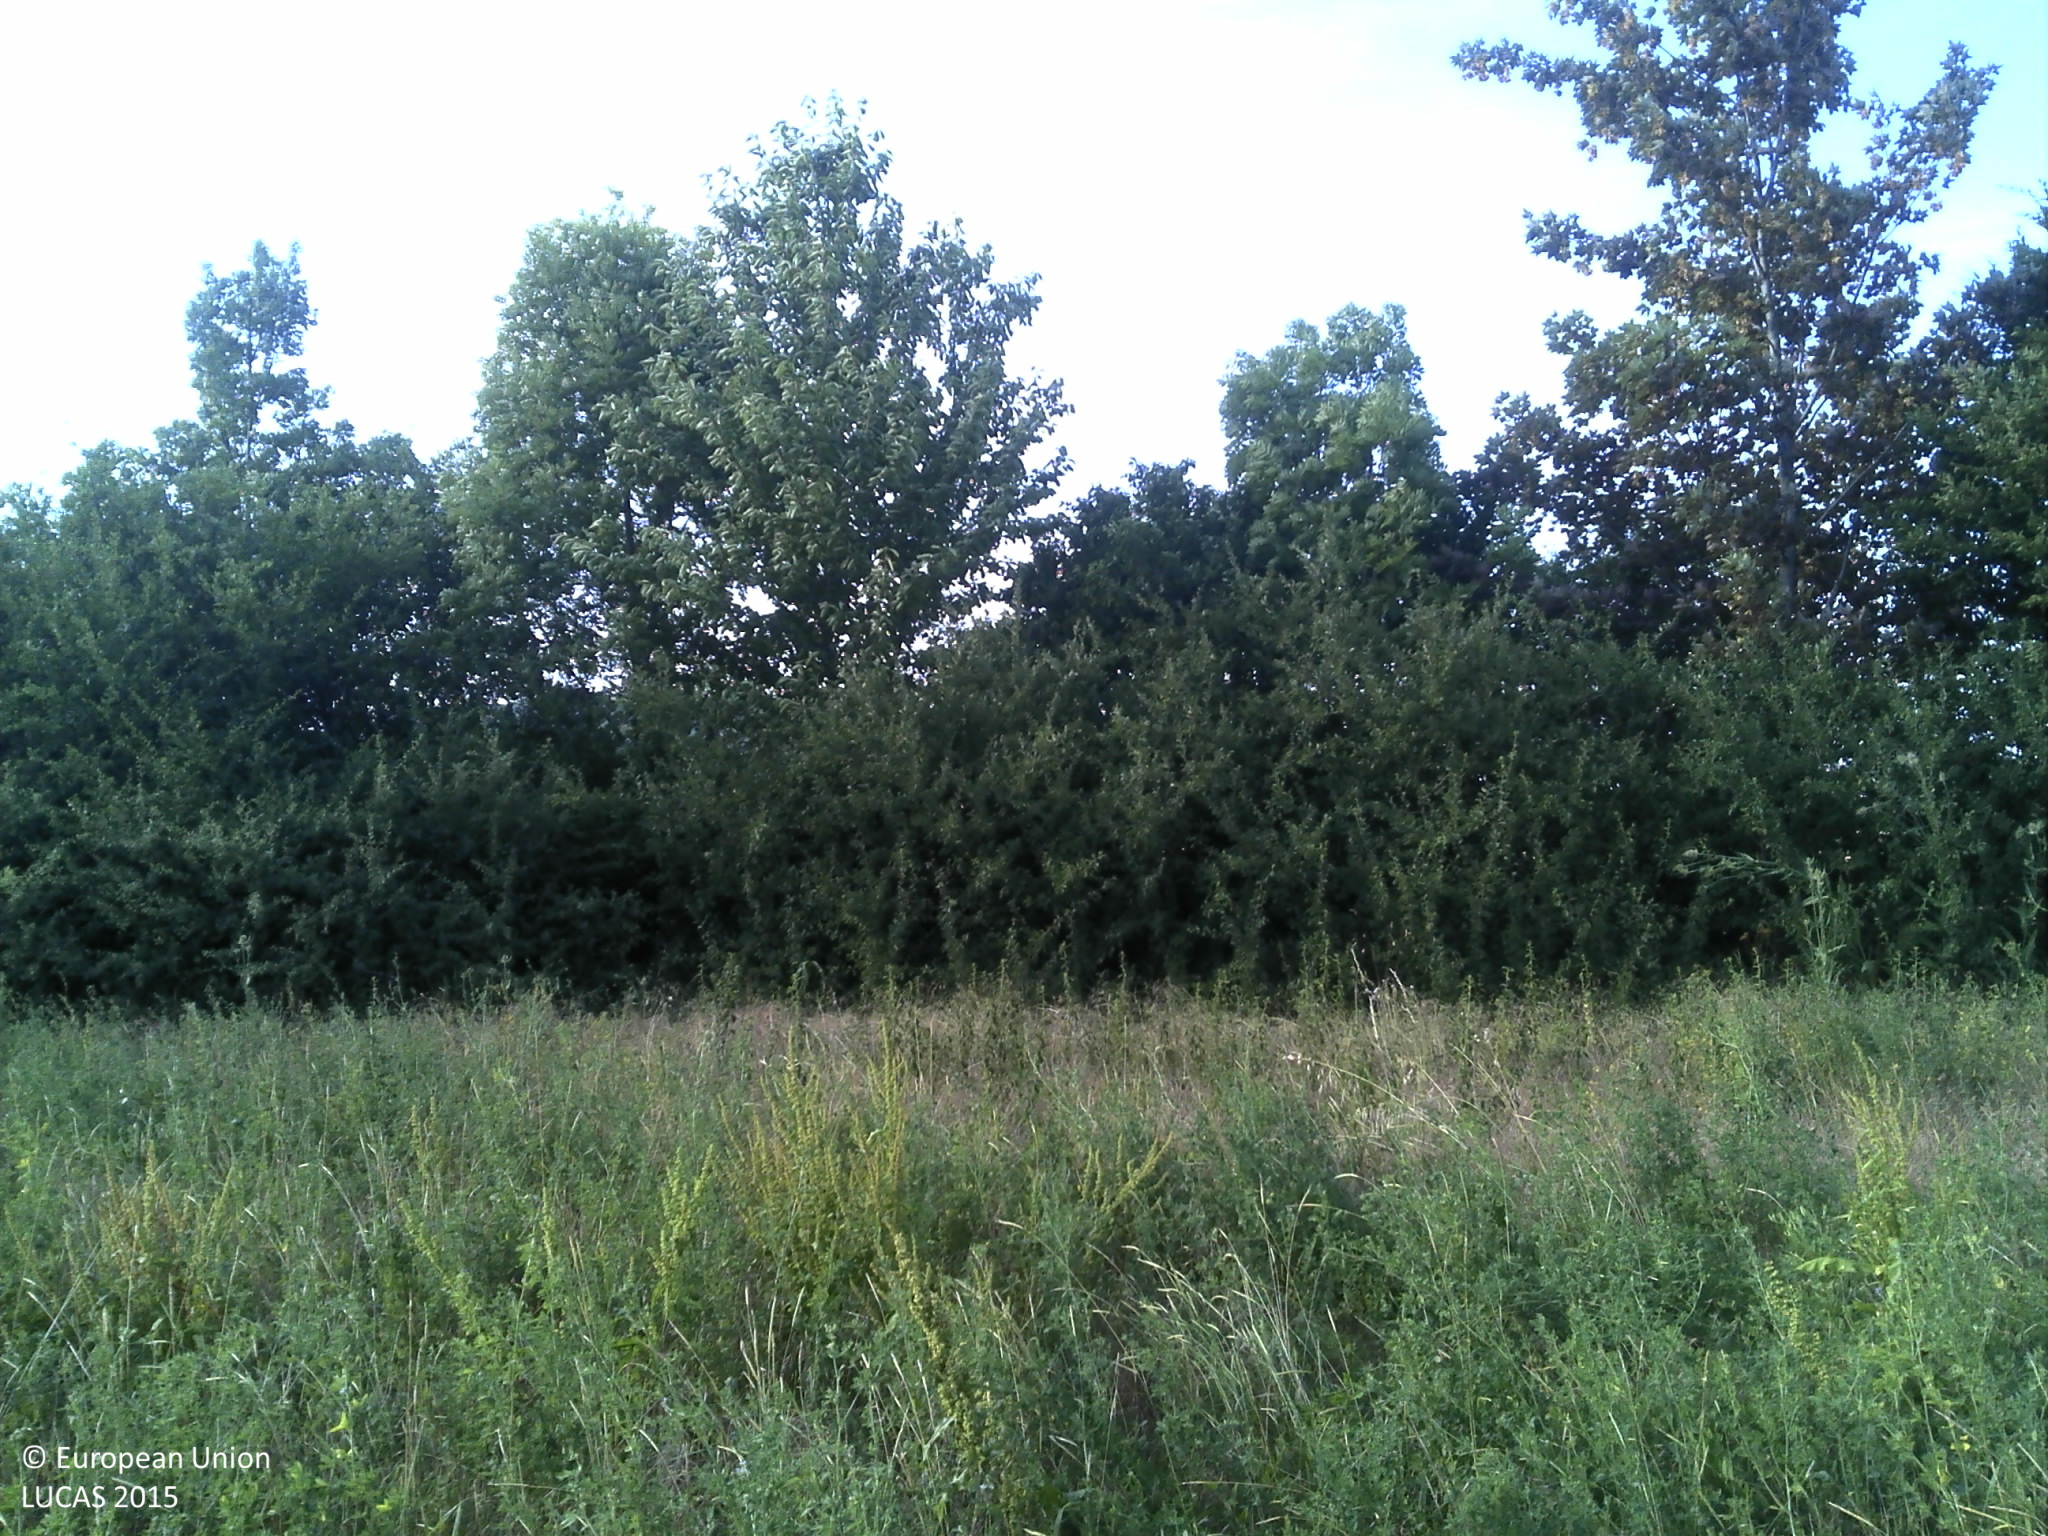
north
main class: Grassland
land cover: Spontaneously vegetated surfaces
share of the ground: > 75 %
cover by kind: herbaceous plants 100 %
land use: Agriculture (excluding fallow land and kitchen gardens)
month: July
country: FR
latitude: 45.7812
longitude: 3.3251
